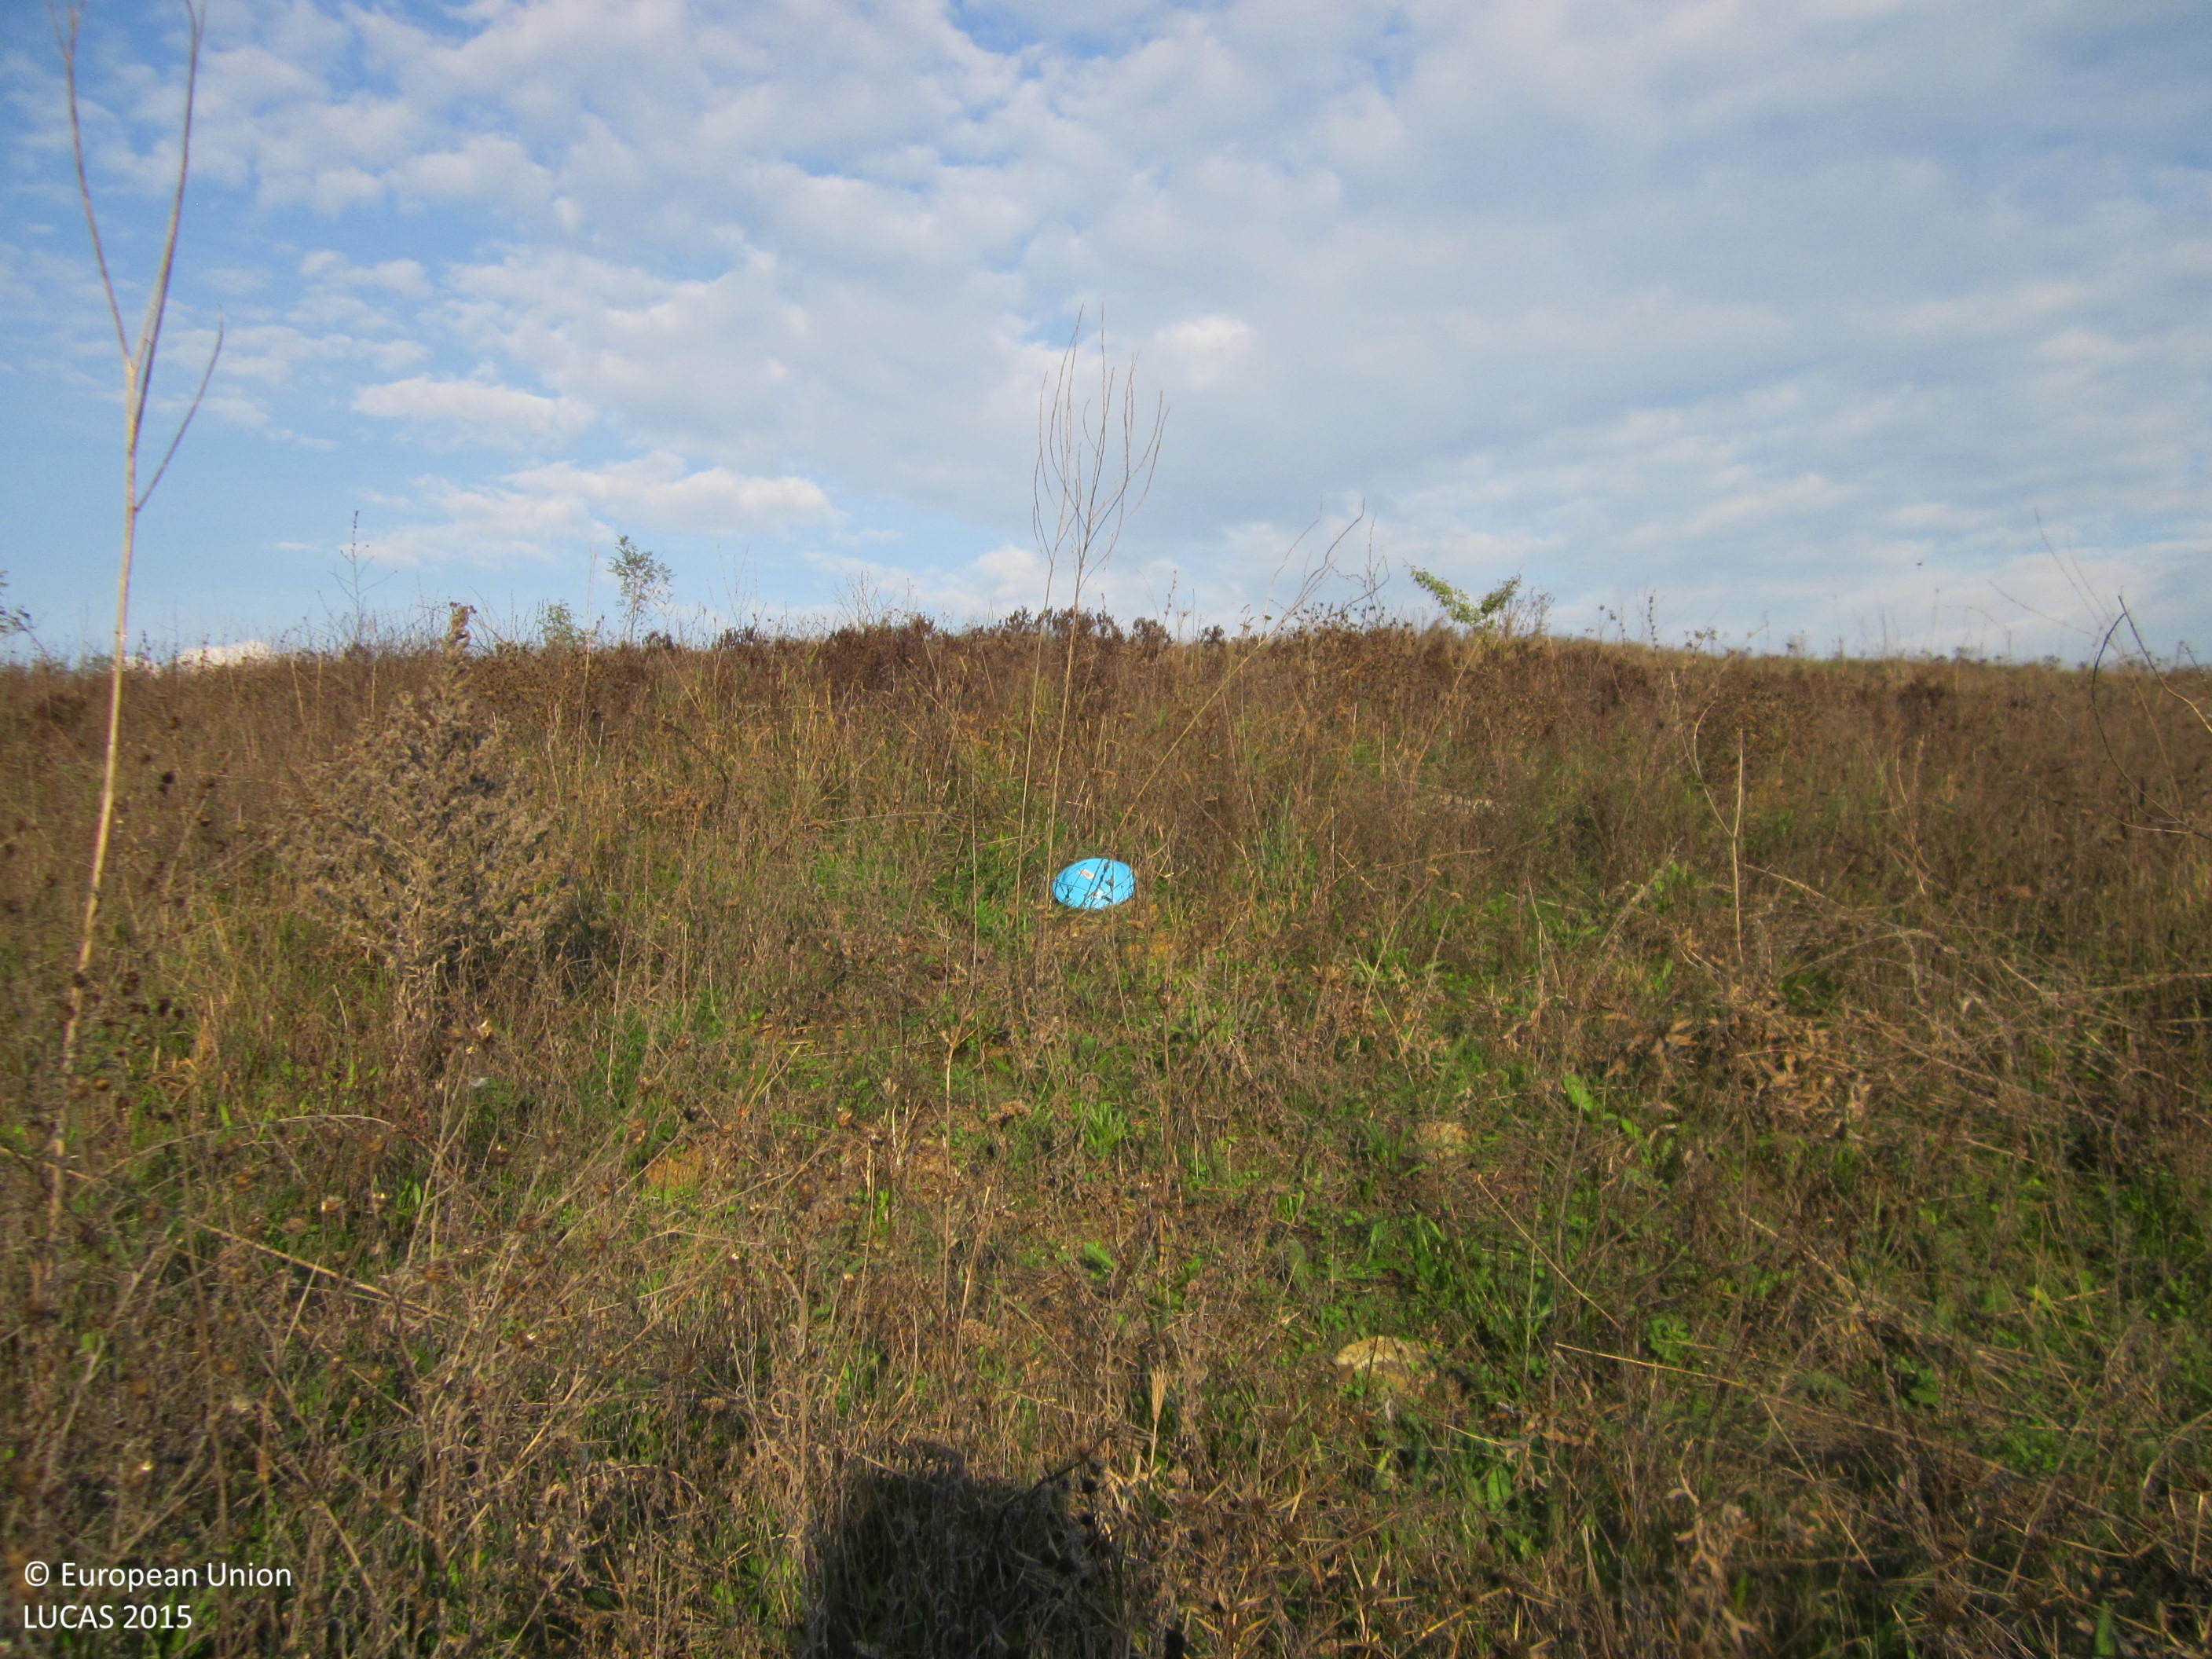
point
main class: Grassland
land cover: Grassland without tree/shrub cover
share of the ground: > 75 %
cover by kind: herbaceous plants 95 %, shrubs 5 %
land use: Agriculture (excluding fallow land and kitchen gardens)
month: October
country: BG
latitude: 42.2996
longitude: 26.9490
